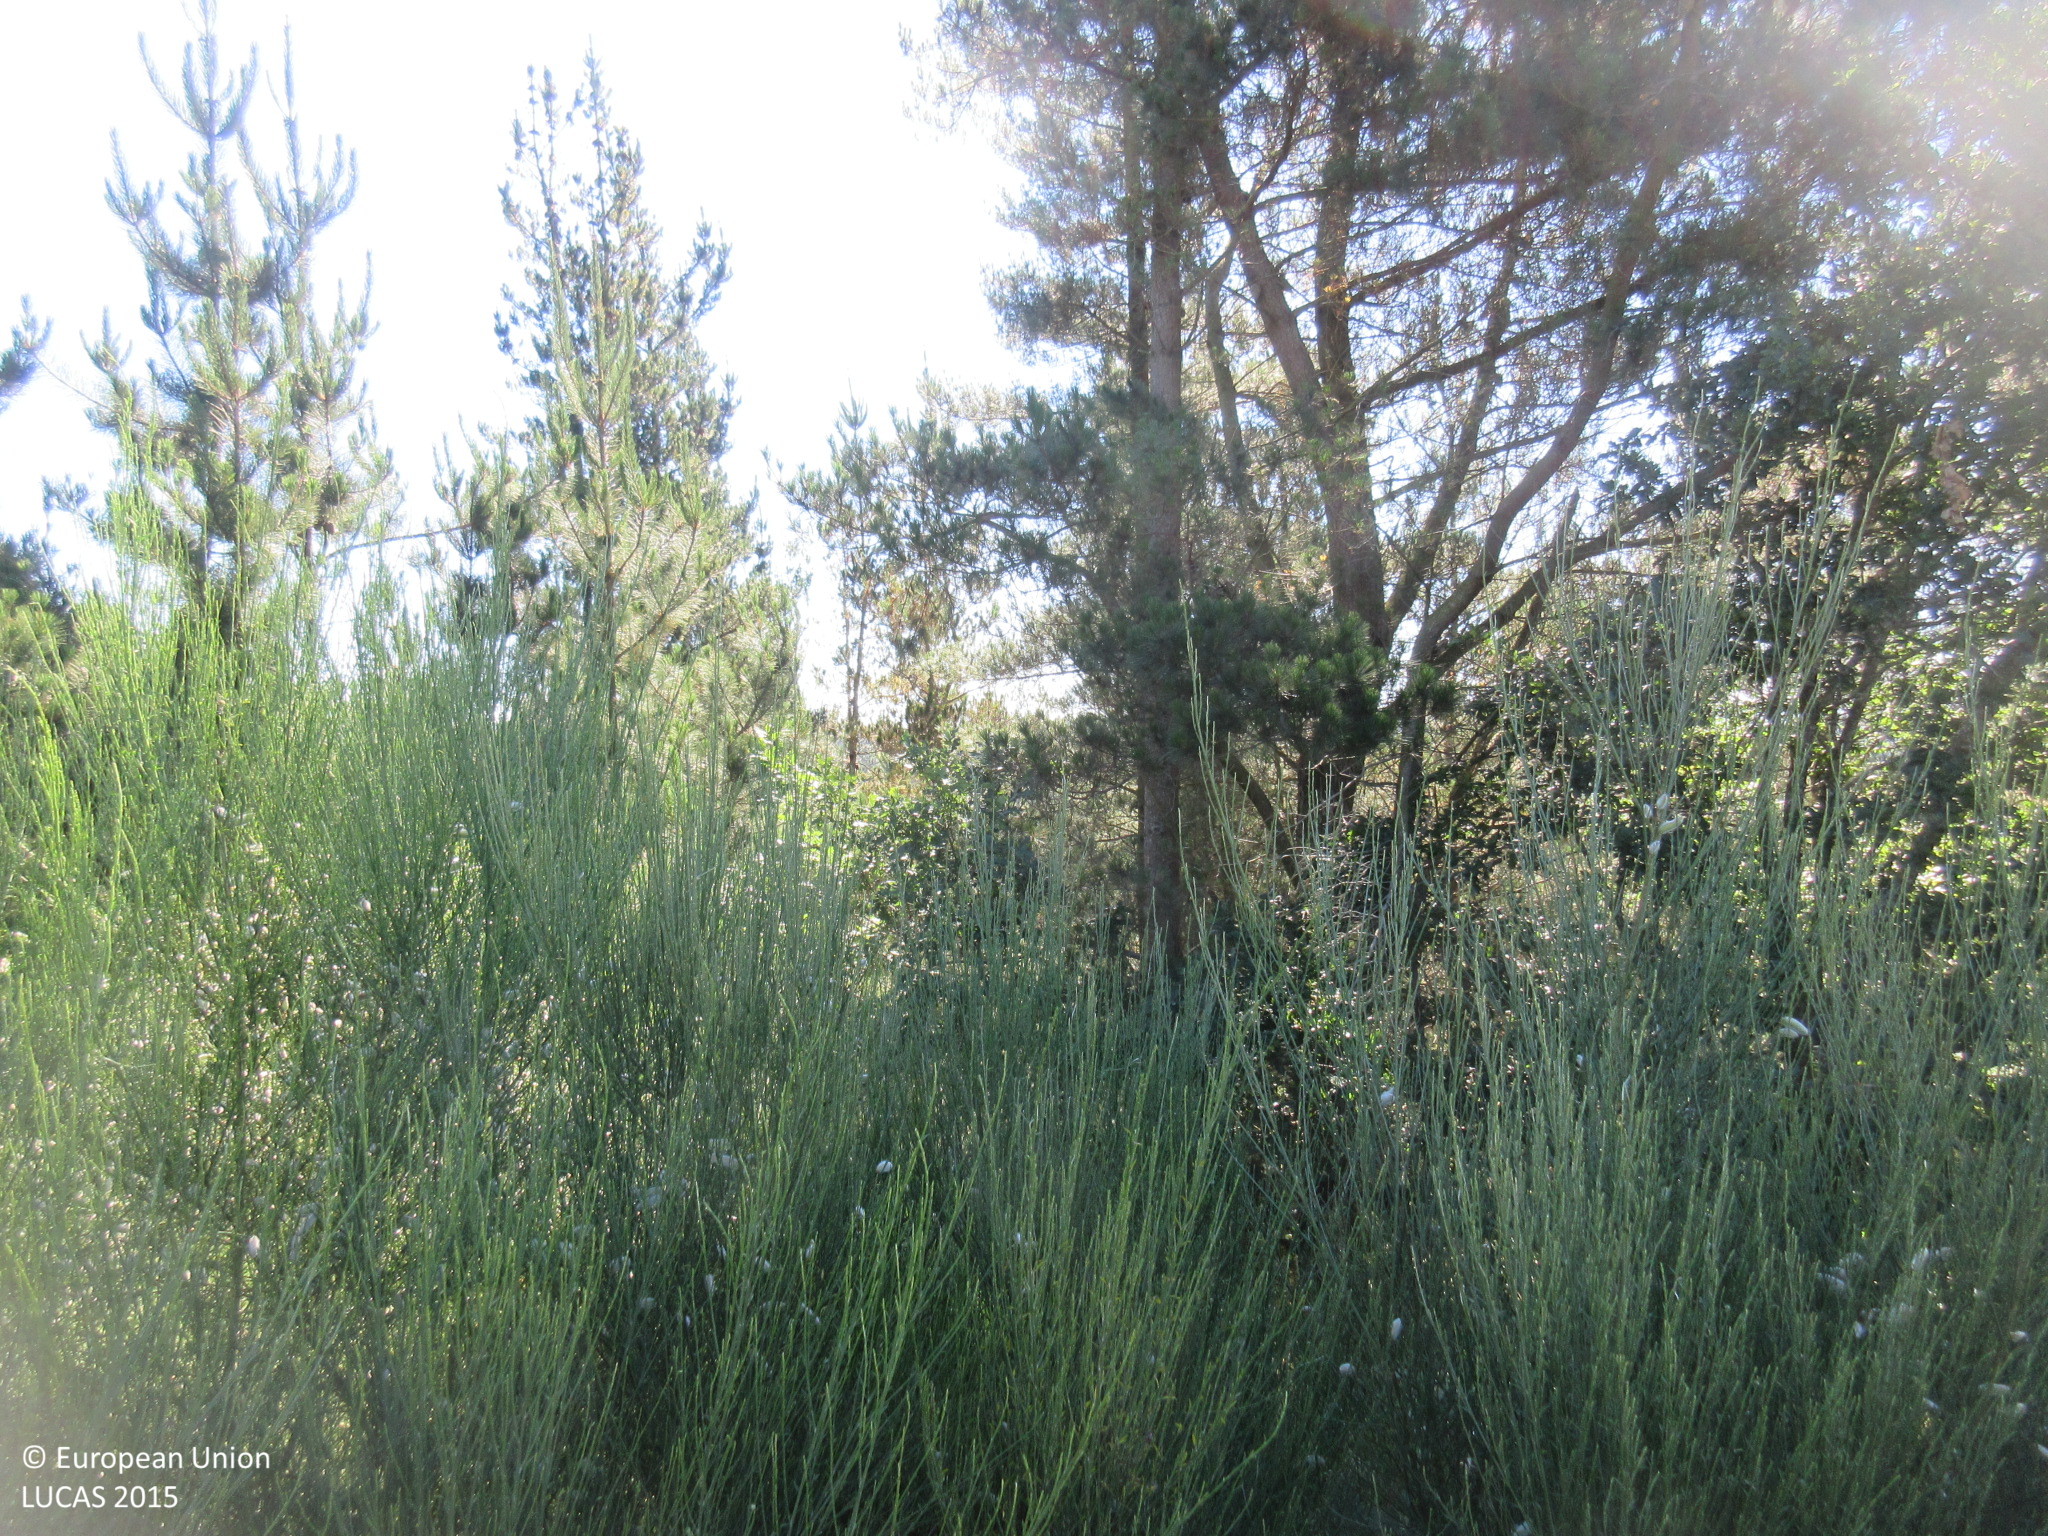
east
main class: Woodland
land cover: Pine dominated coniferous woodland
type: hemiboreal forest and nemoral coniferous forest and mixed broadleaved-coniferous forest
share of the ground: > 75 %
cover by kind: coniferous forest trees 90 %, broadleaved forest trees 10 %
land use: Forestry
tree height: > 5 m
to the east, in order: Pine dominated coniferous woodland; Broadleaved woodland; Pine dominated coniferous woodland
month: June
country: ES
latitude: 43.2452
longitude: -7.1257
